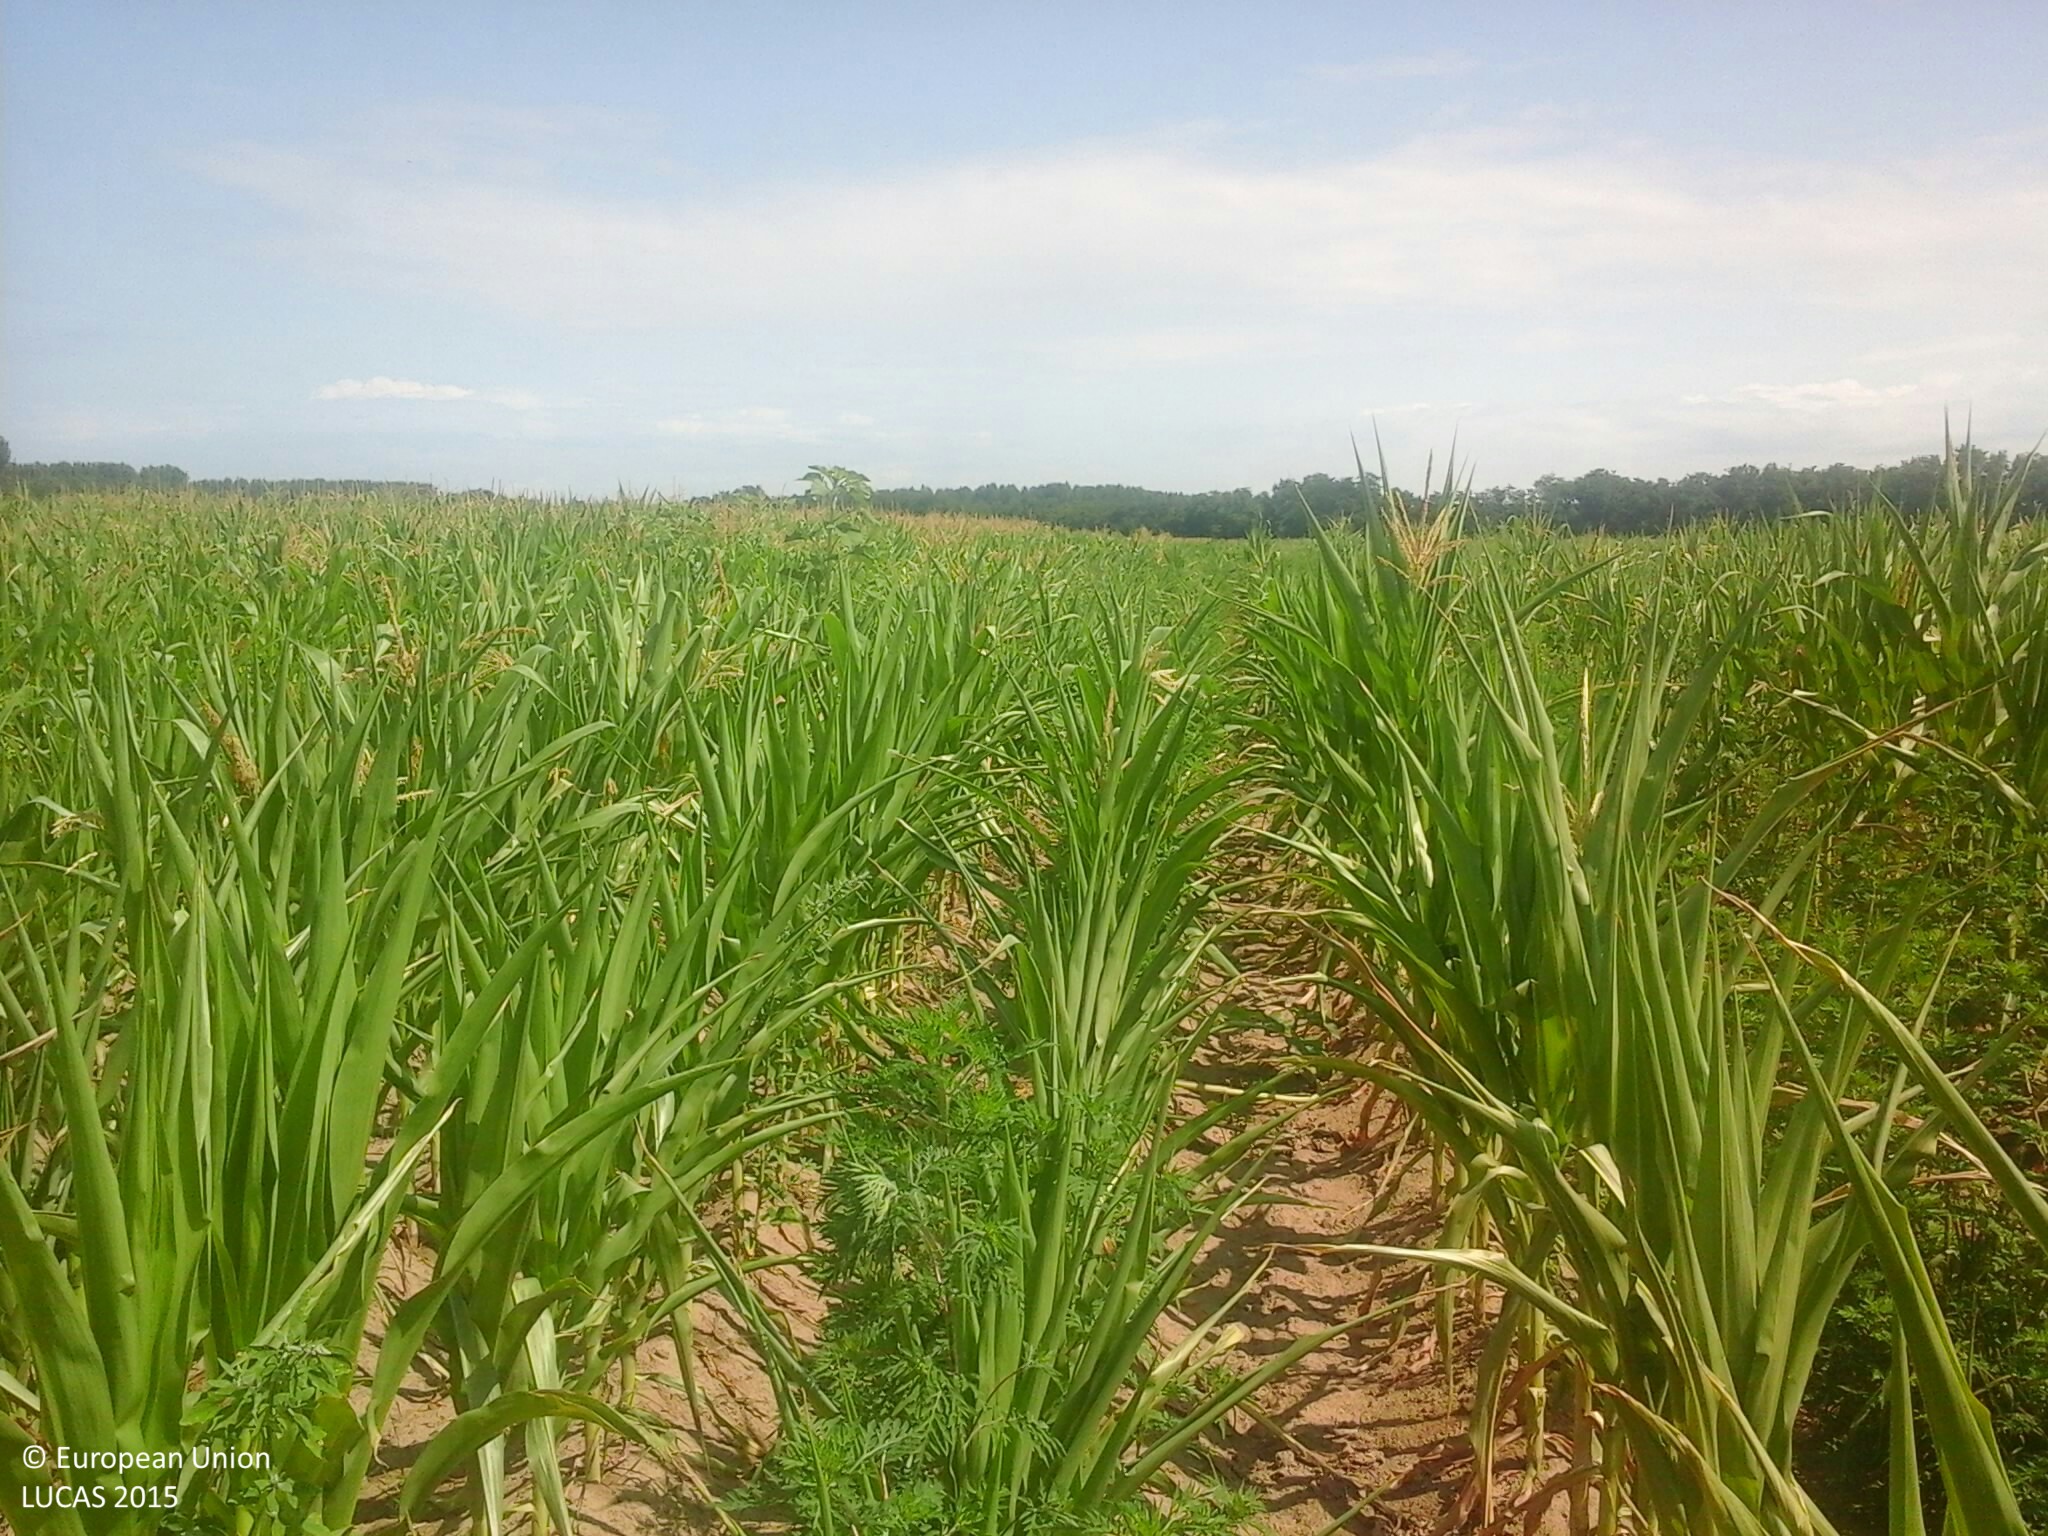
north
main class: Cropland
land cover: Maize
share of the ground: 50 - 75 %
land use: Agriculture (excluding fallow land and kitchen gardens)
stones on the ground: < 10 %
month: July
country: HU
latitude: 47.8580
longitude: 22.1498
